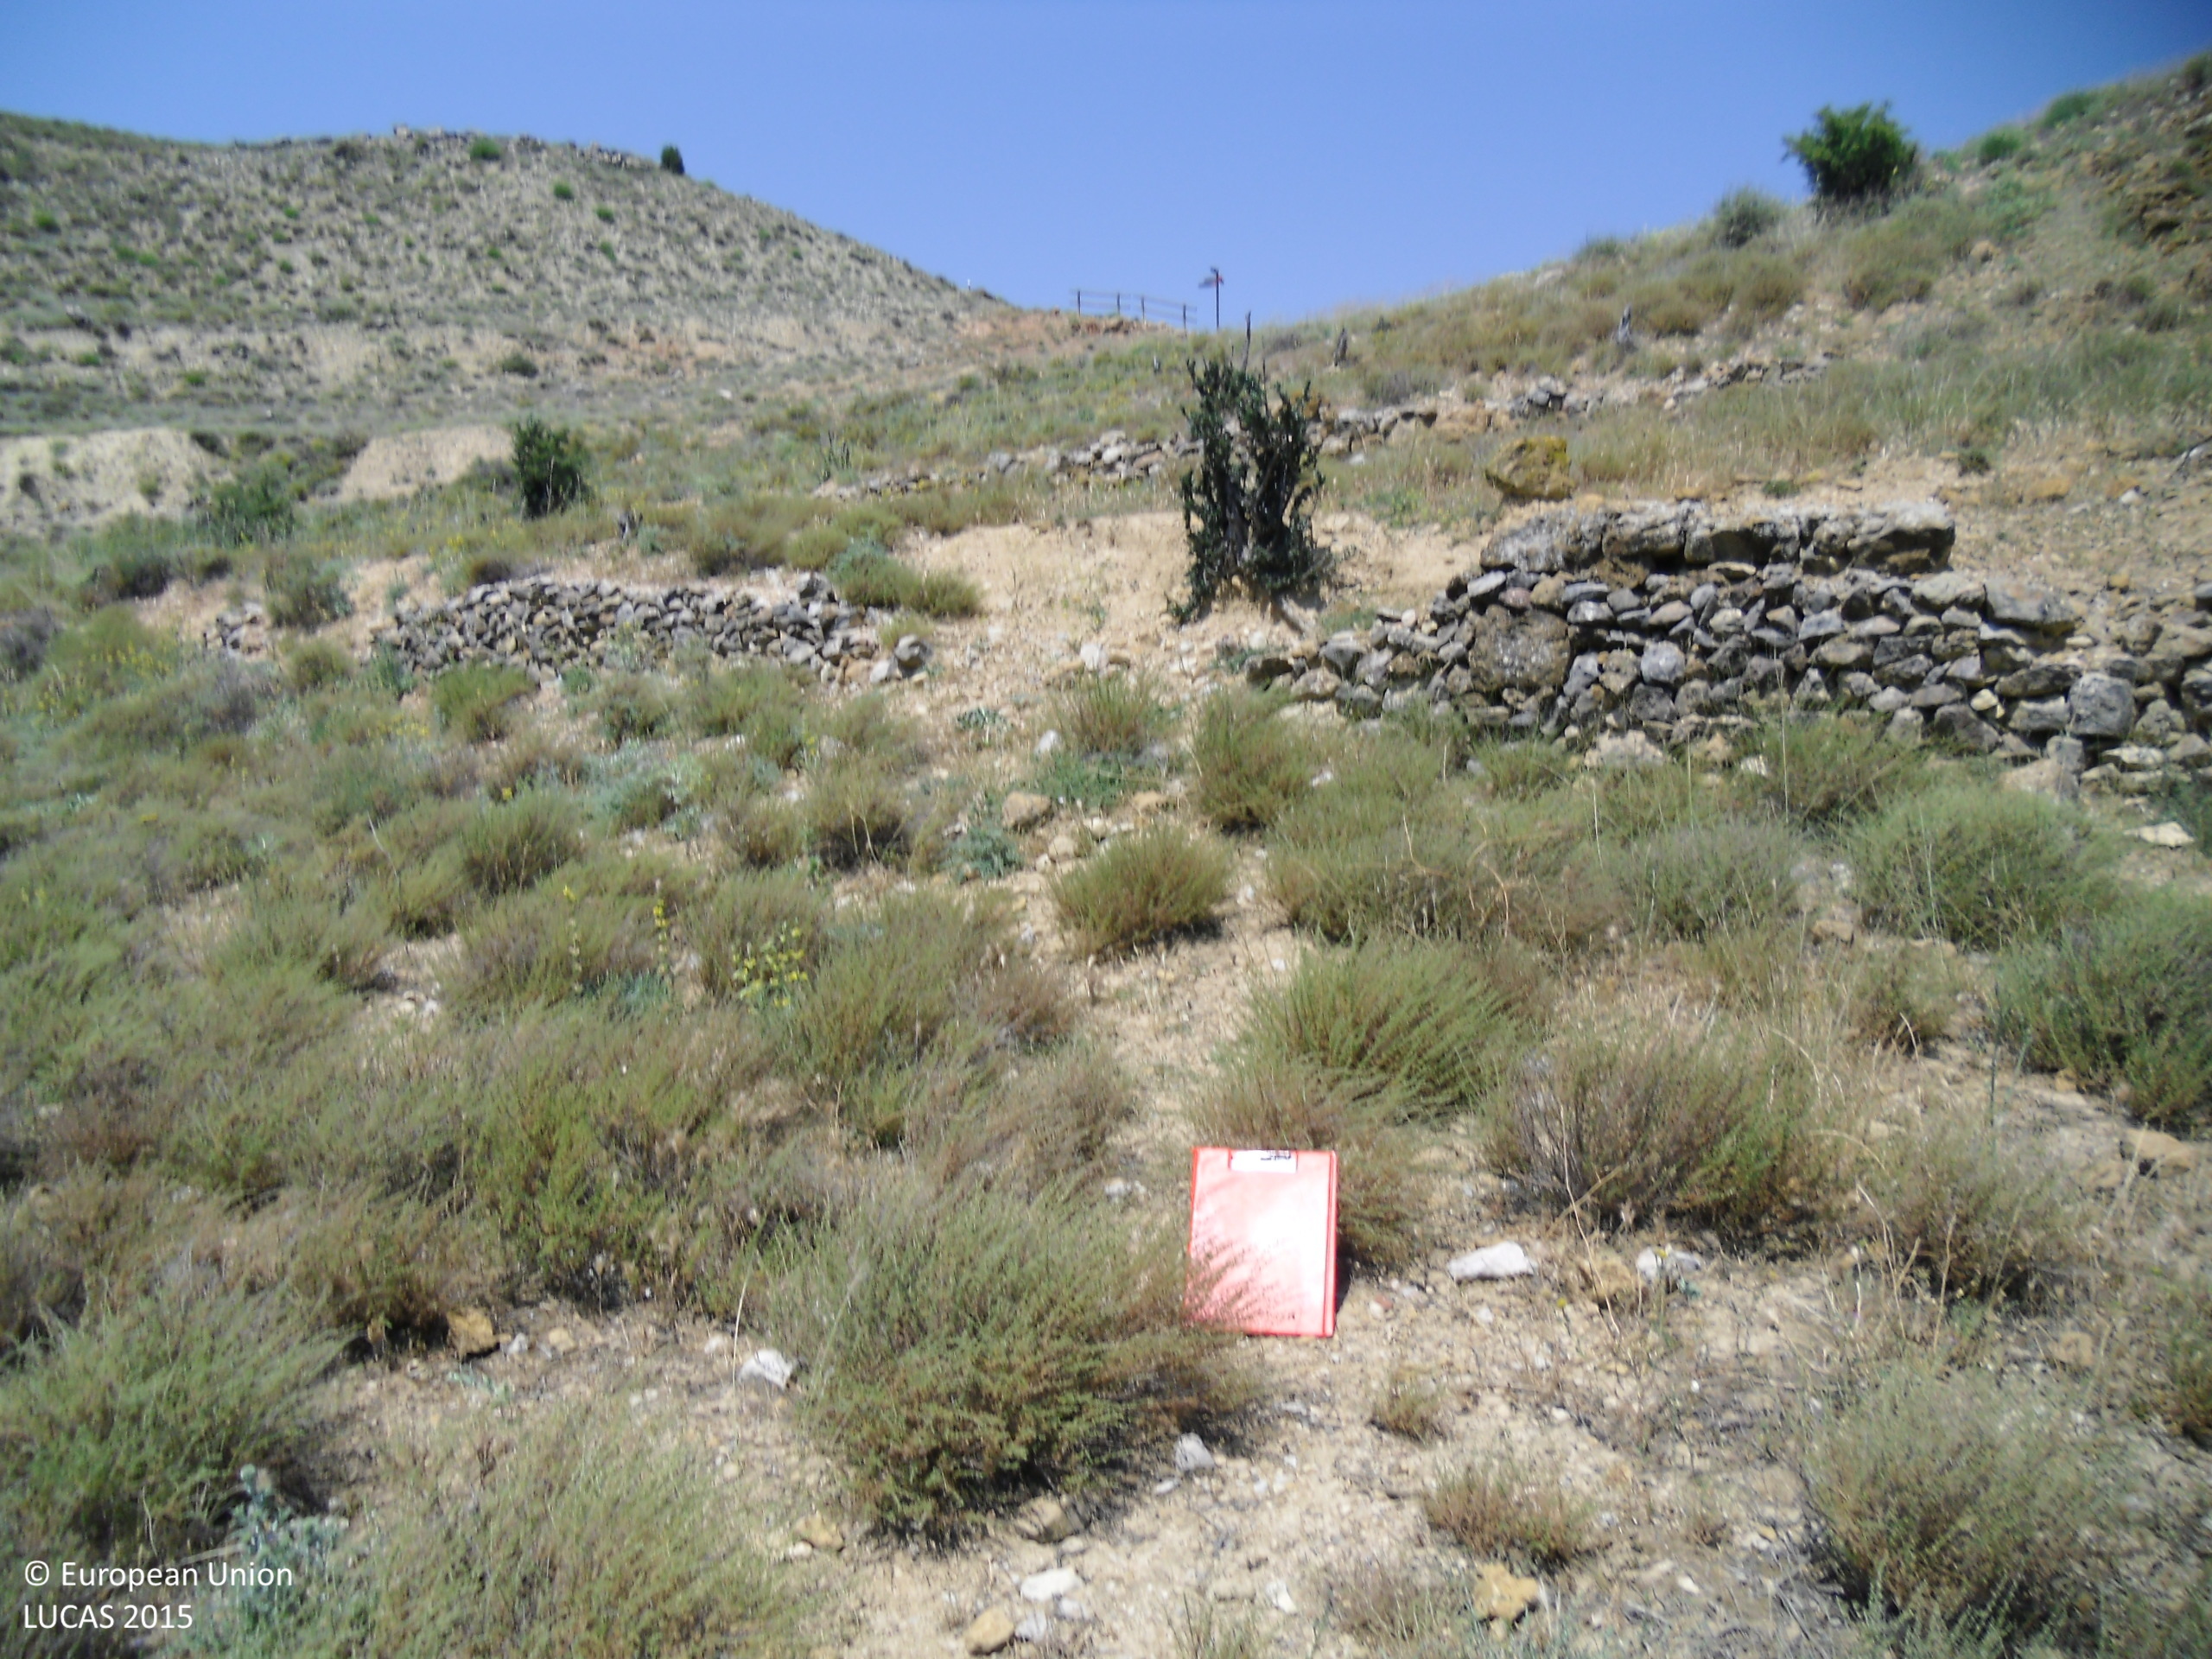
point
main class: Grassland
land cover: Grassland with sparse tree/shrub cover
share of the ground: 50 - 75 %
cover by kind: herbaceous plants 75 %, unconsolidated bare surface 15 %, coniferous forest trees 5 %, shrubs 5 %
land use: Agriculture (excluding fallow land and kitchen gardens)
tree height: < 5 m
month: June
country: ES
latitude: 40.9954
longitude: -0.6774
